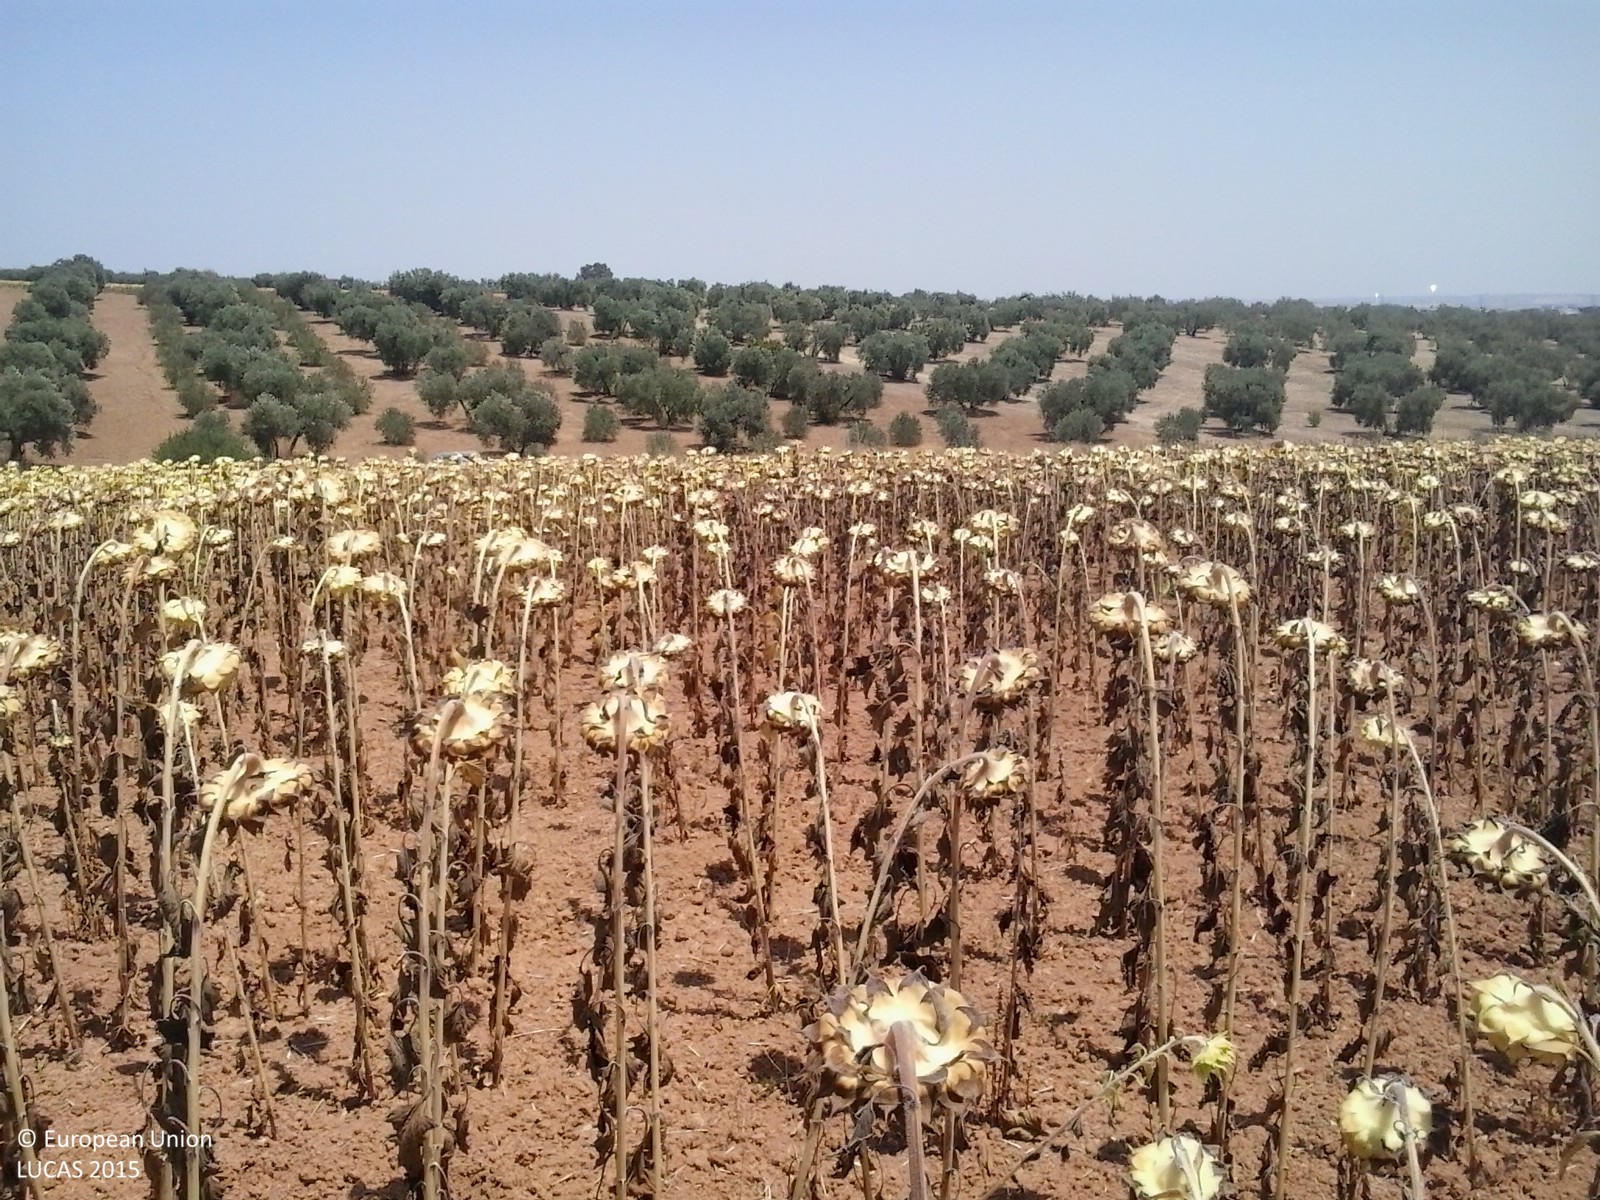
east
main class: Cropland
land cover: Sunflower
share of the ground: 25 - 50 %
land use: Agriculture (excluding fallow land and kitchen gardens)
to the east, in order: Sunflower; Grass margins; Ditches and canals; Tracks; Ditches and canals; Olive groves; Sunflower; Olive groves
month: July
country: ES
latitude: 37.4727
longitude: -6.4171
